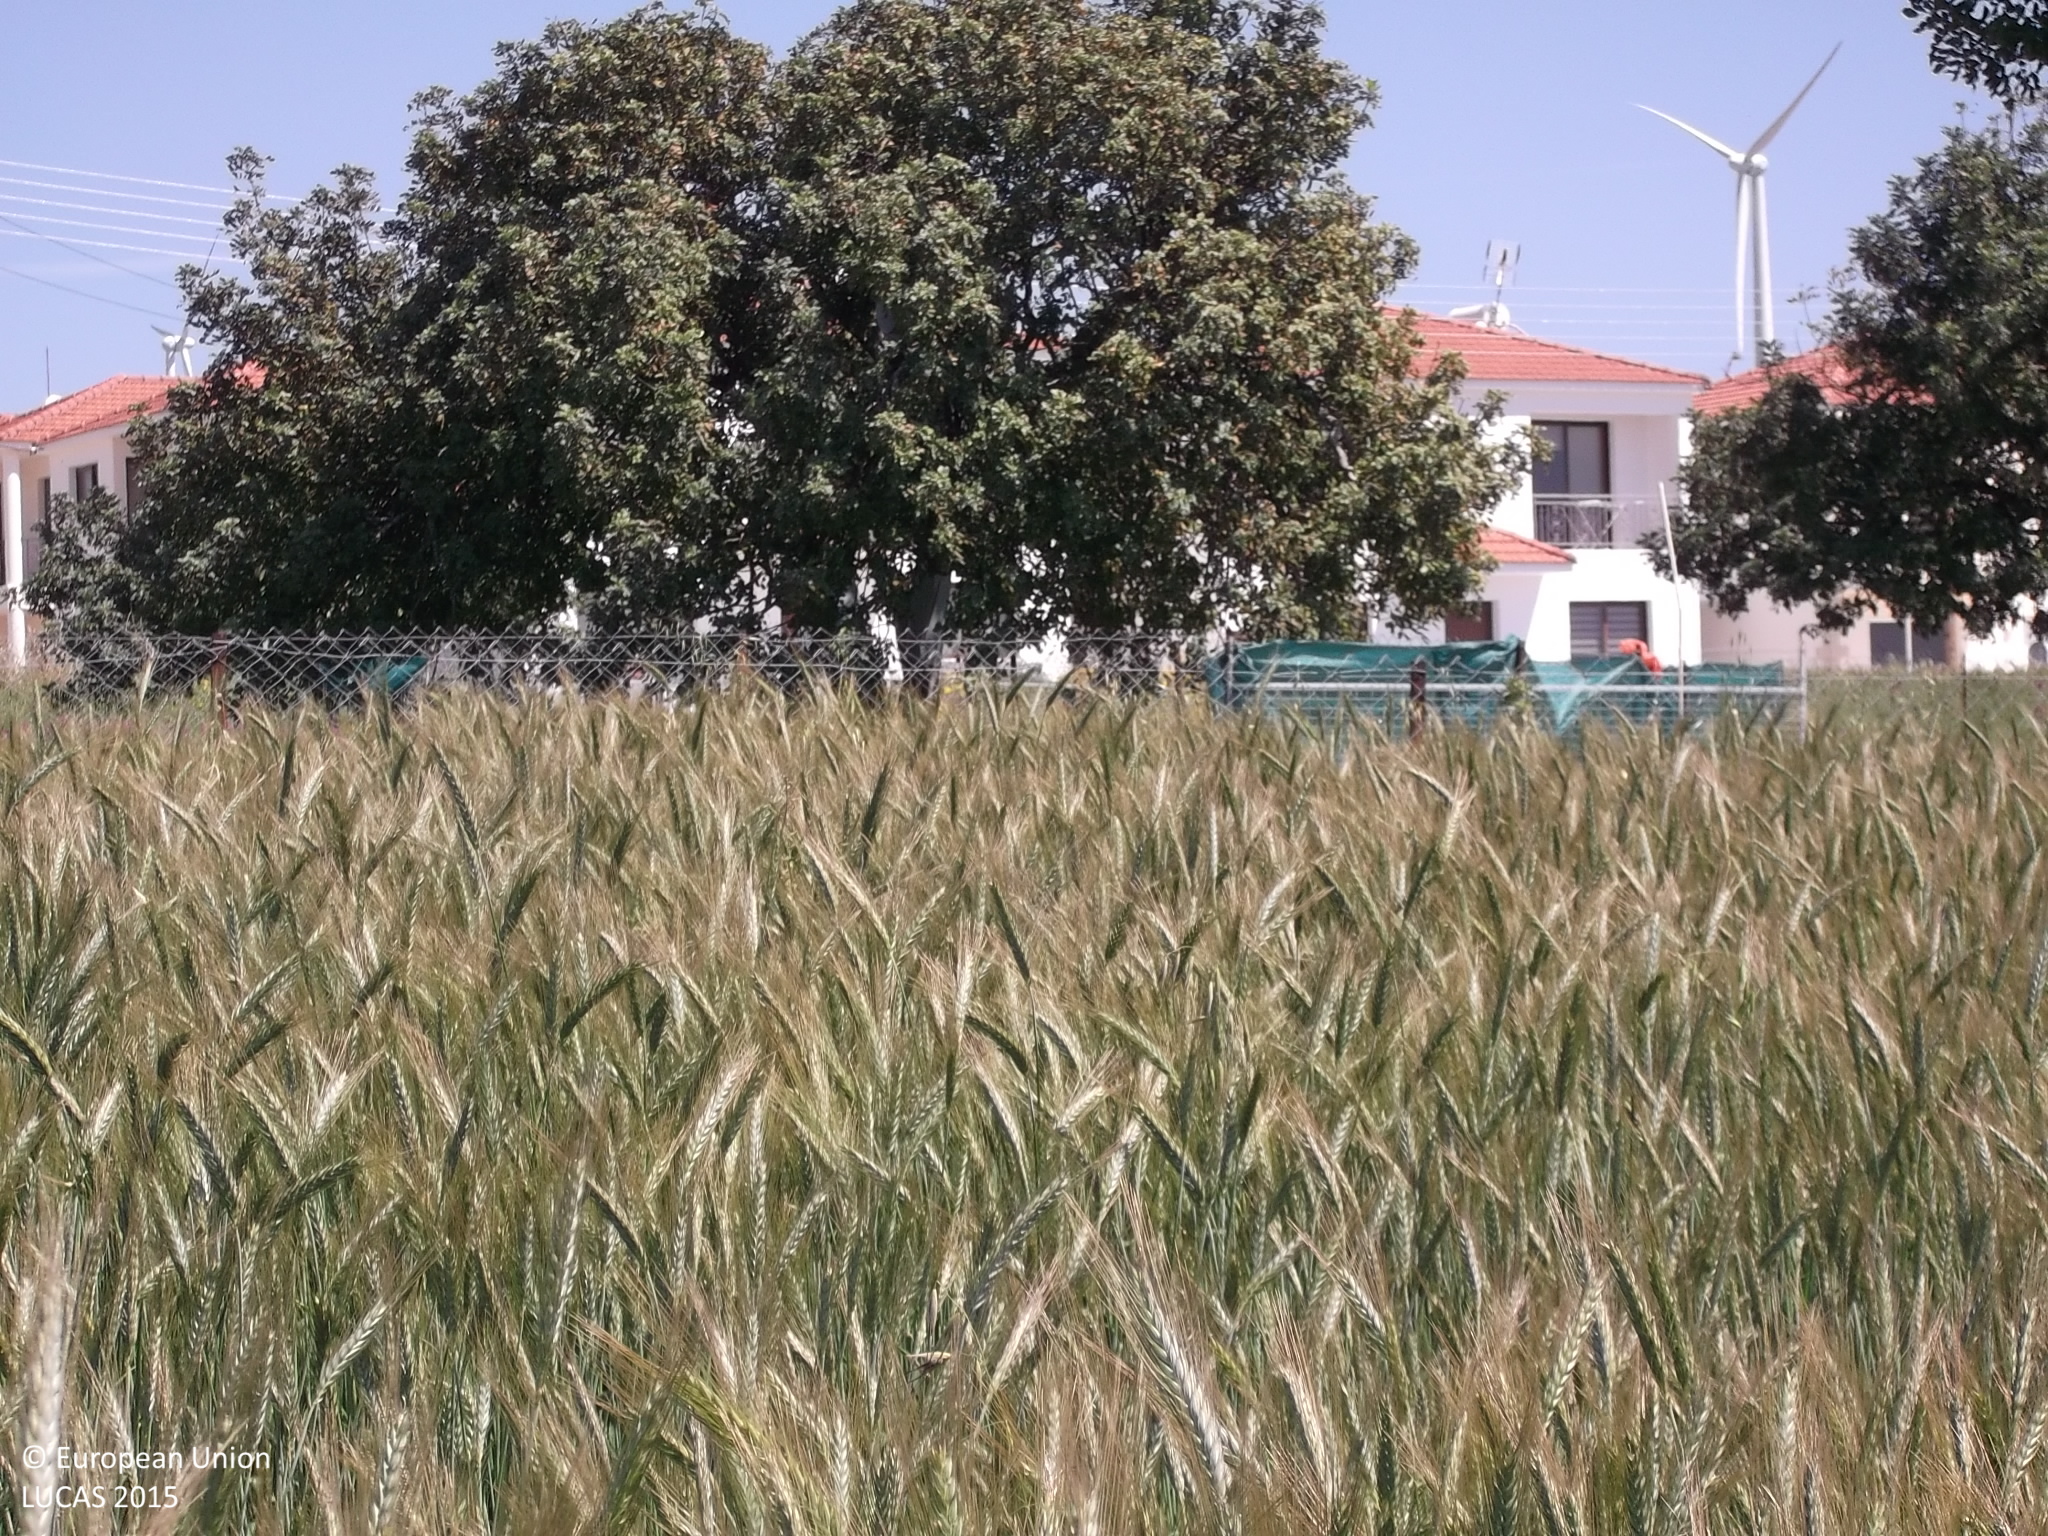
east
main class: Cropland
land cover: Common wheat
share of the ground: > 75 %
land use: Agriculture (excluding fallow land and kitchen gardens)
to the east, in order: Common wheat; Fences; Permanent industrial crops; Fences; Artificial constructions in urban areas; Grassland with sparse tree/shrub cover; Paved roads, cycling and walking lanes; Permanent industrial crops; Electric lines; Permanent industrial crops; Paved roads, cycling and walking lanes
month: April
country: CY
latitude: 34.8706
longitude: 33.5018
